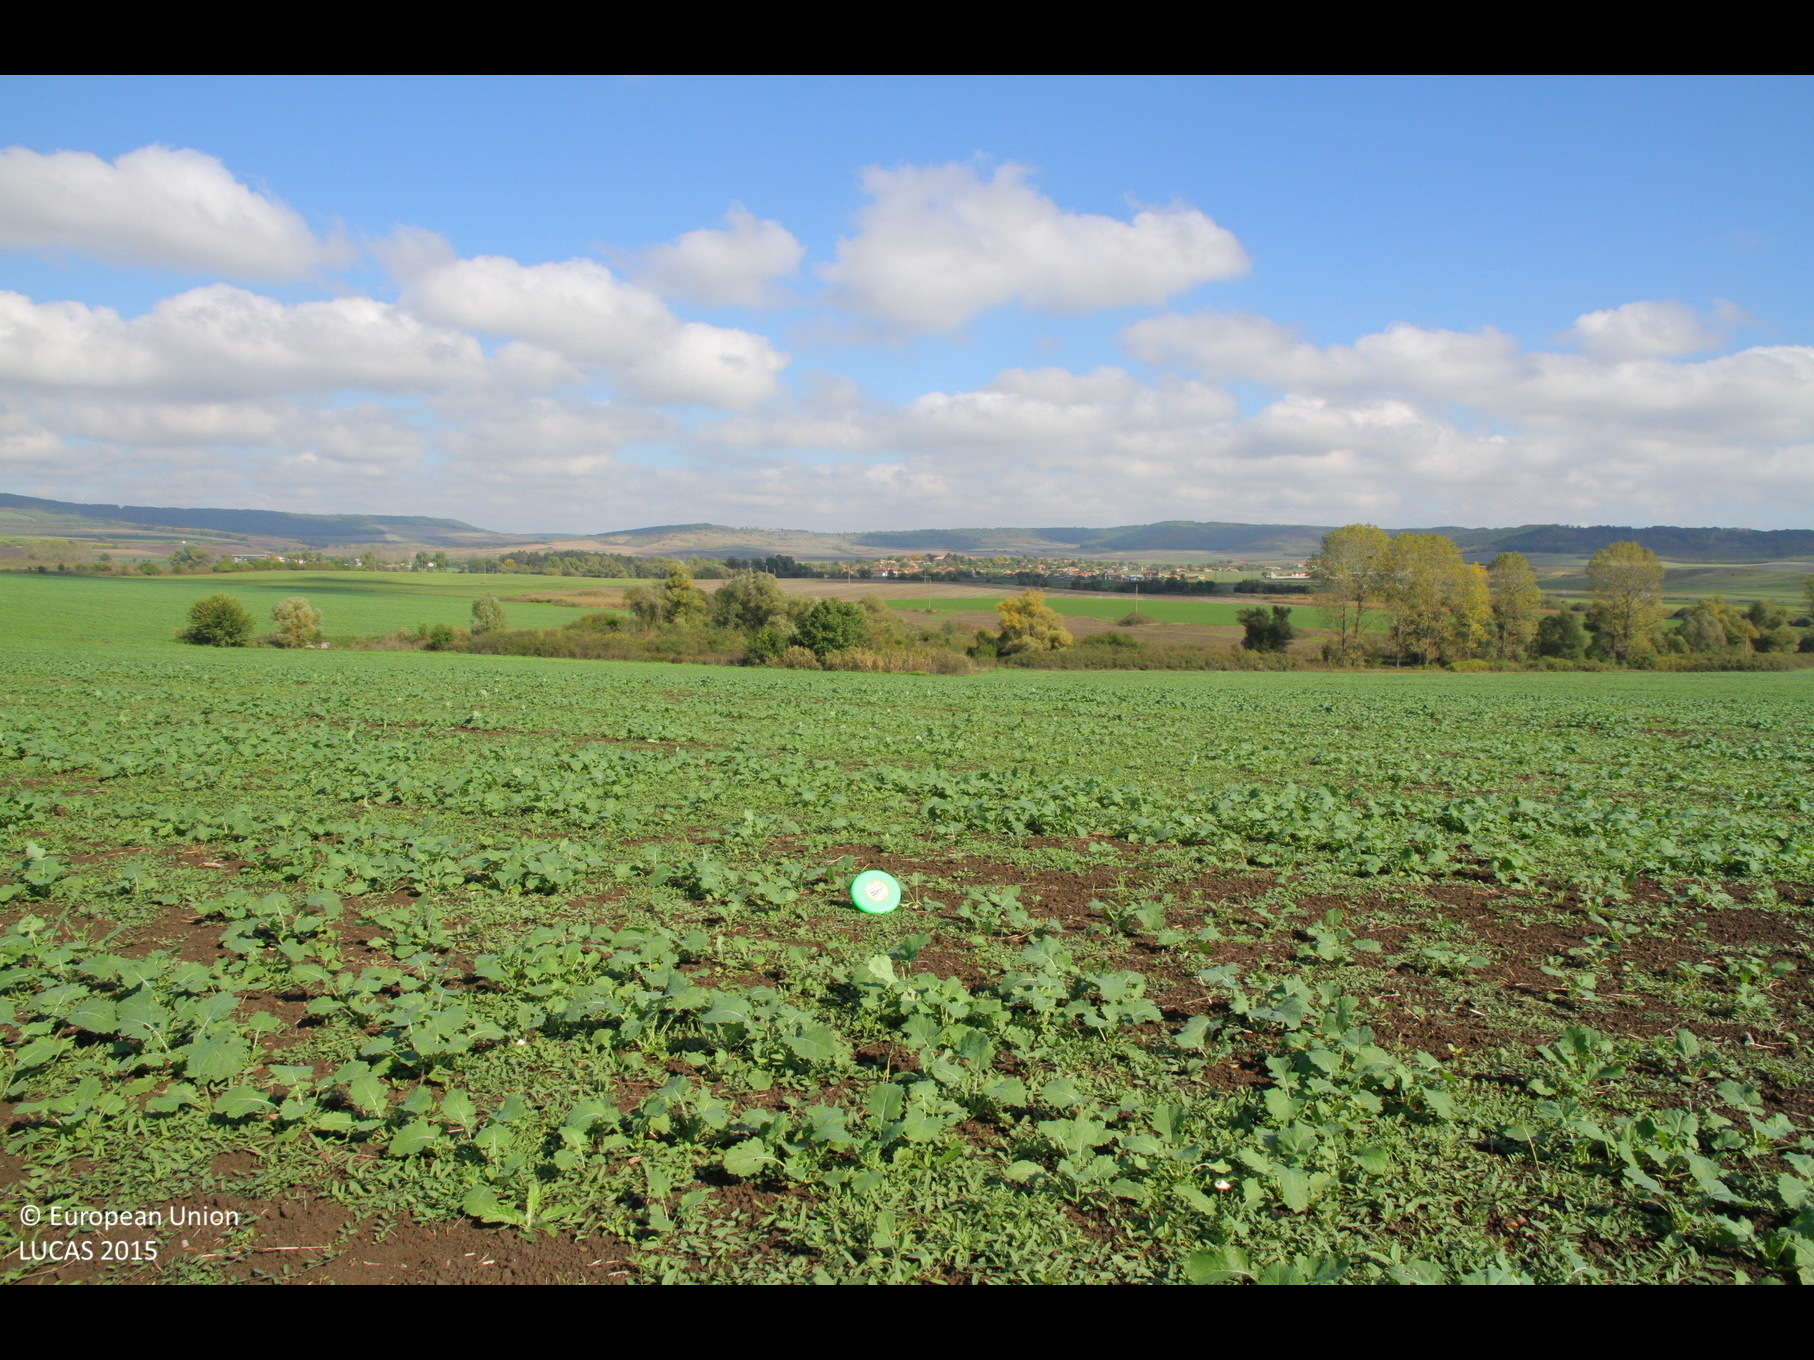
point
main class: Cropland
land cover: Rape and turnip rape
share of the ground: 25 - 50 %
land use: Agriculture (excluding fallow land and kitchen gardens)
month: October
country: BG
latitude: 43.3633
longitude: 26.5278
